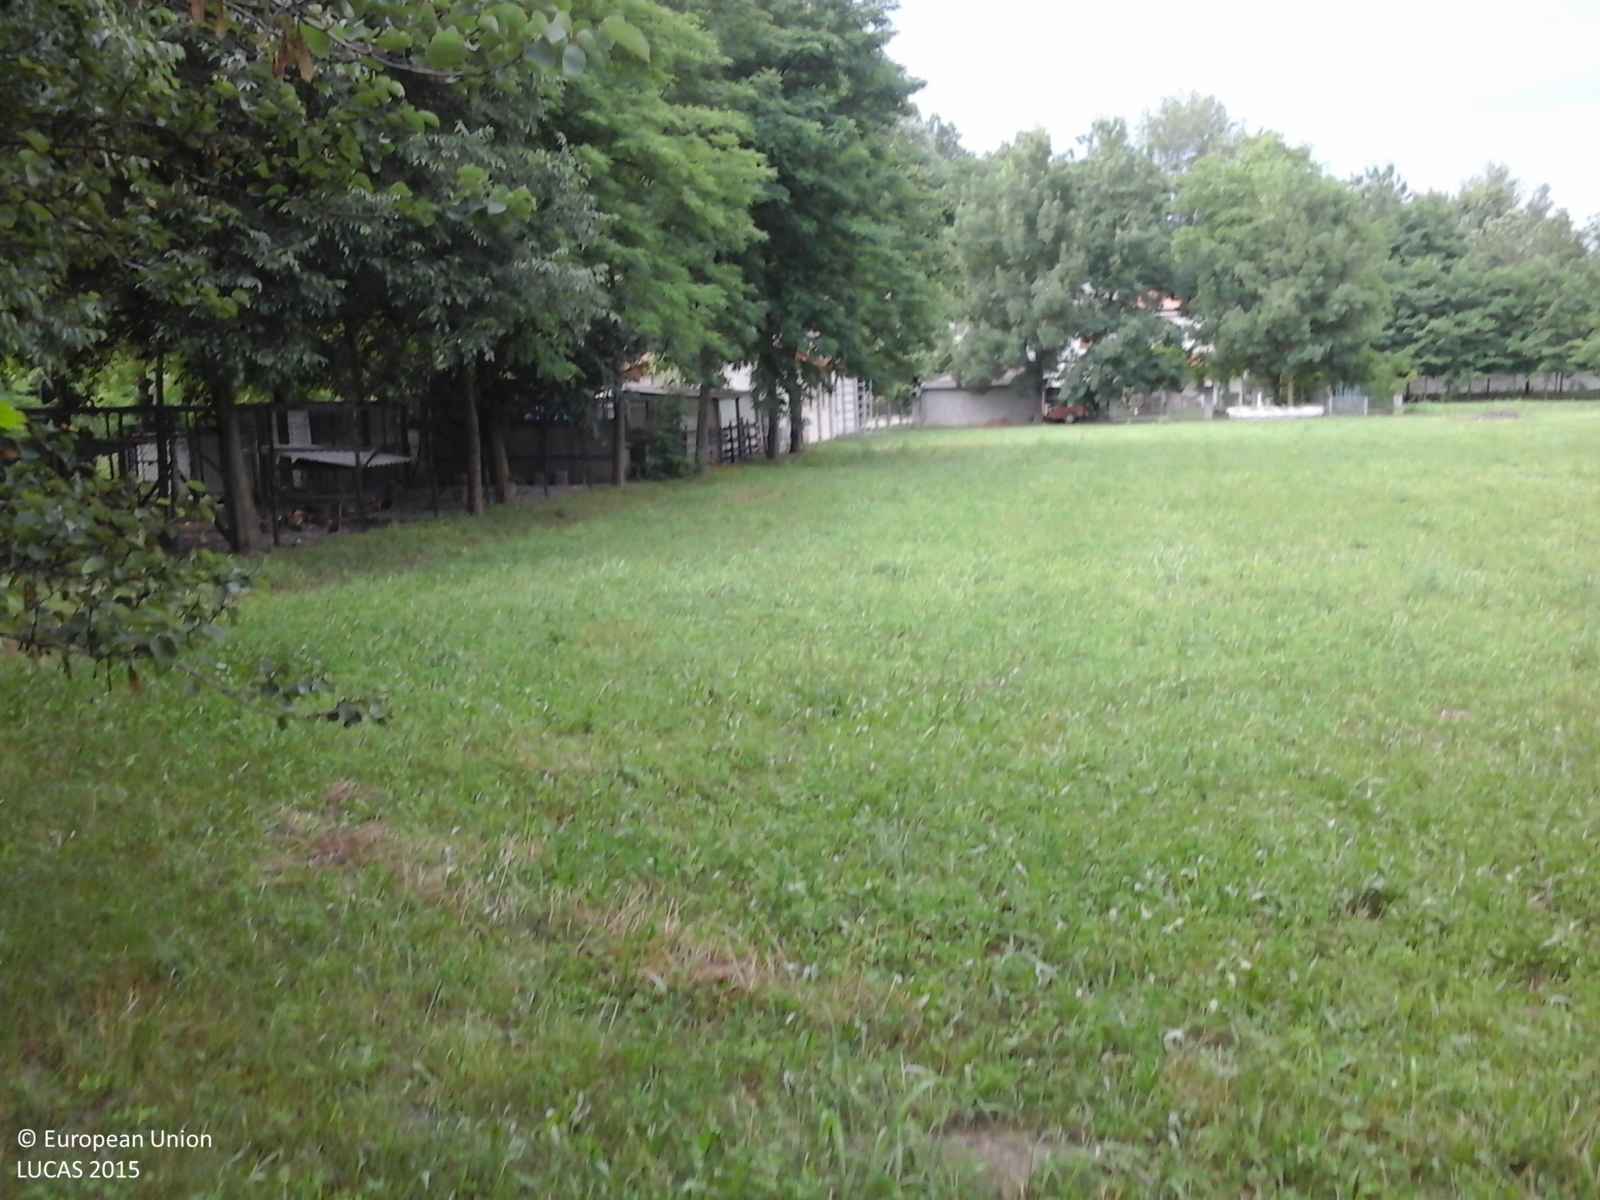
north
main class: Artificial land
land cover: Non built-up linear features
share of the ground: > 75 %
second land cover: Grassland without tree/shrub cover
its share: 10 - 25 %
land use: Road transport
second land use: Agriculture (excluding fallow land and kitchen gardens)
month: June
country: IT
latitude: 45.7673
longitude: 12.3241
